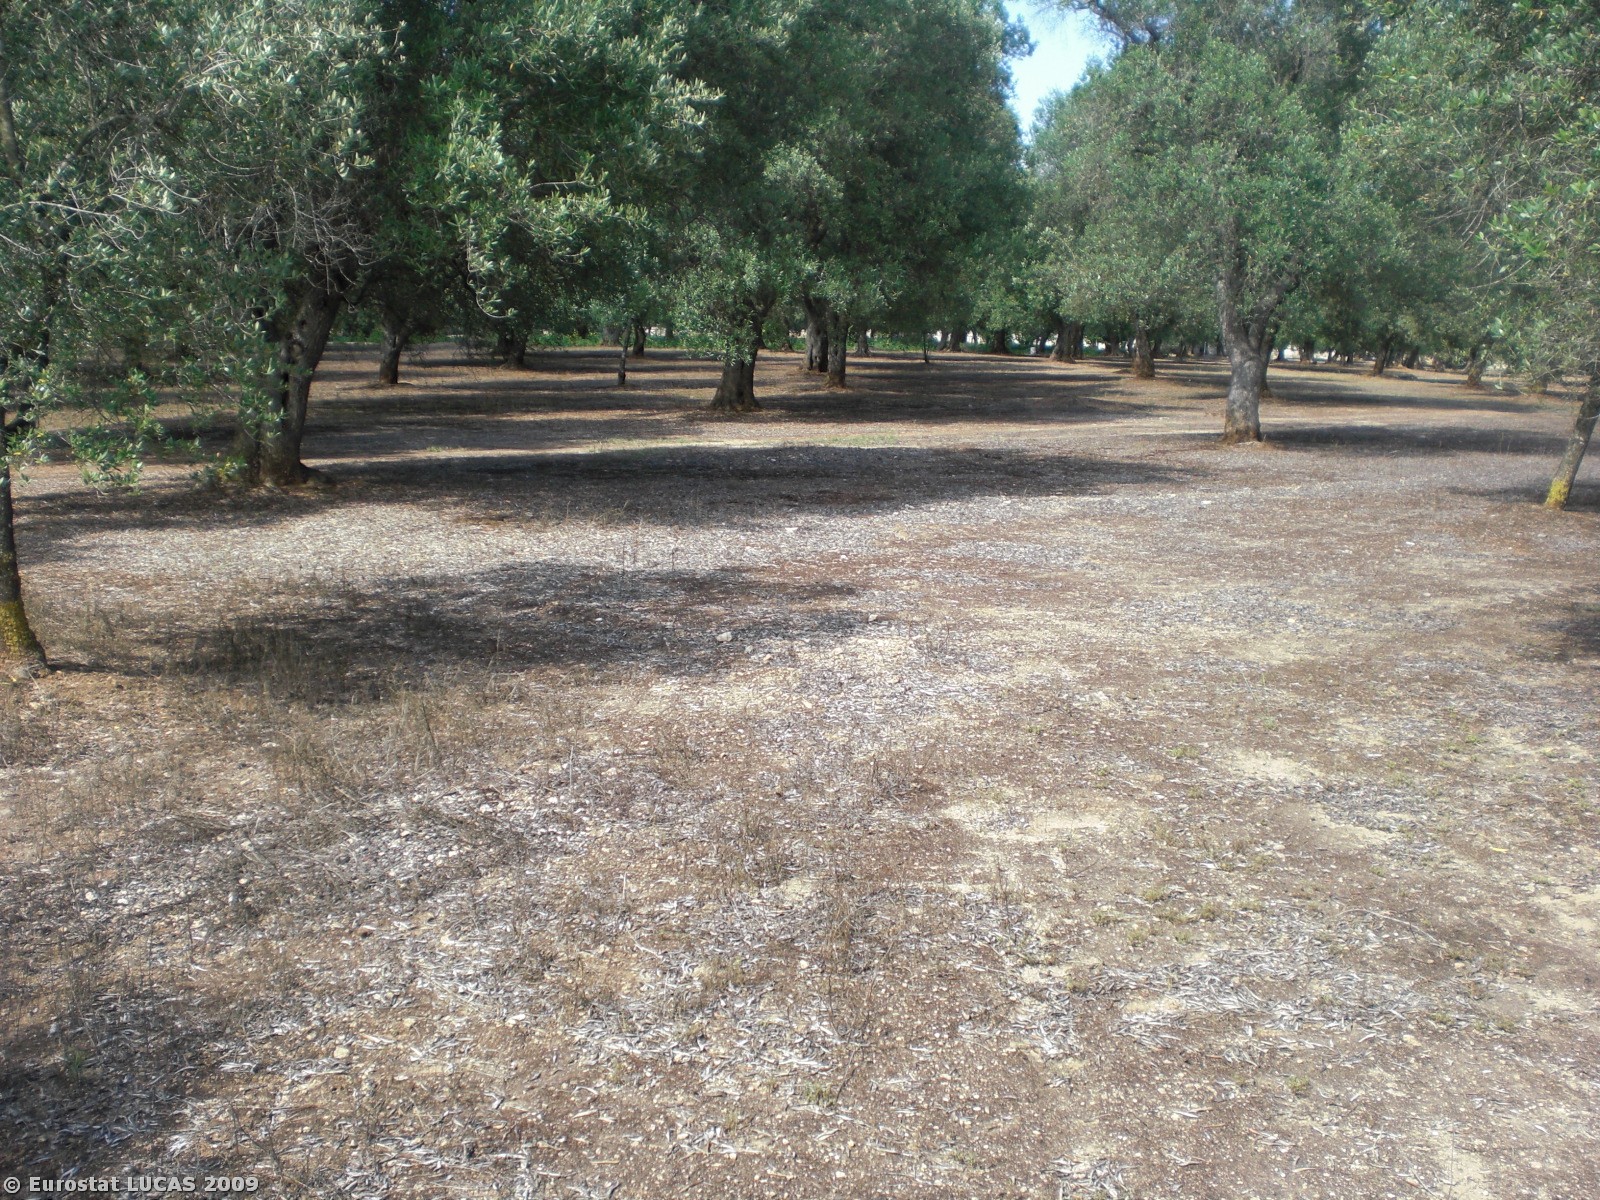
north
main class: Cropland
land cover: Olive groves
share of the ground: > 75 %
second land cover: Bare land
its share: 50 - 75 %
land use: Agriculture (excluding fallow land and kitchen gardens)
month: July
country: IT
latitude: 40.4731
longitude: 18.1502
